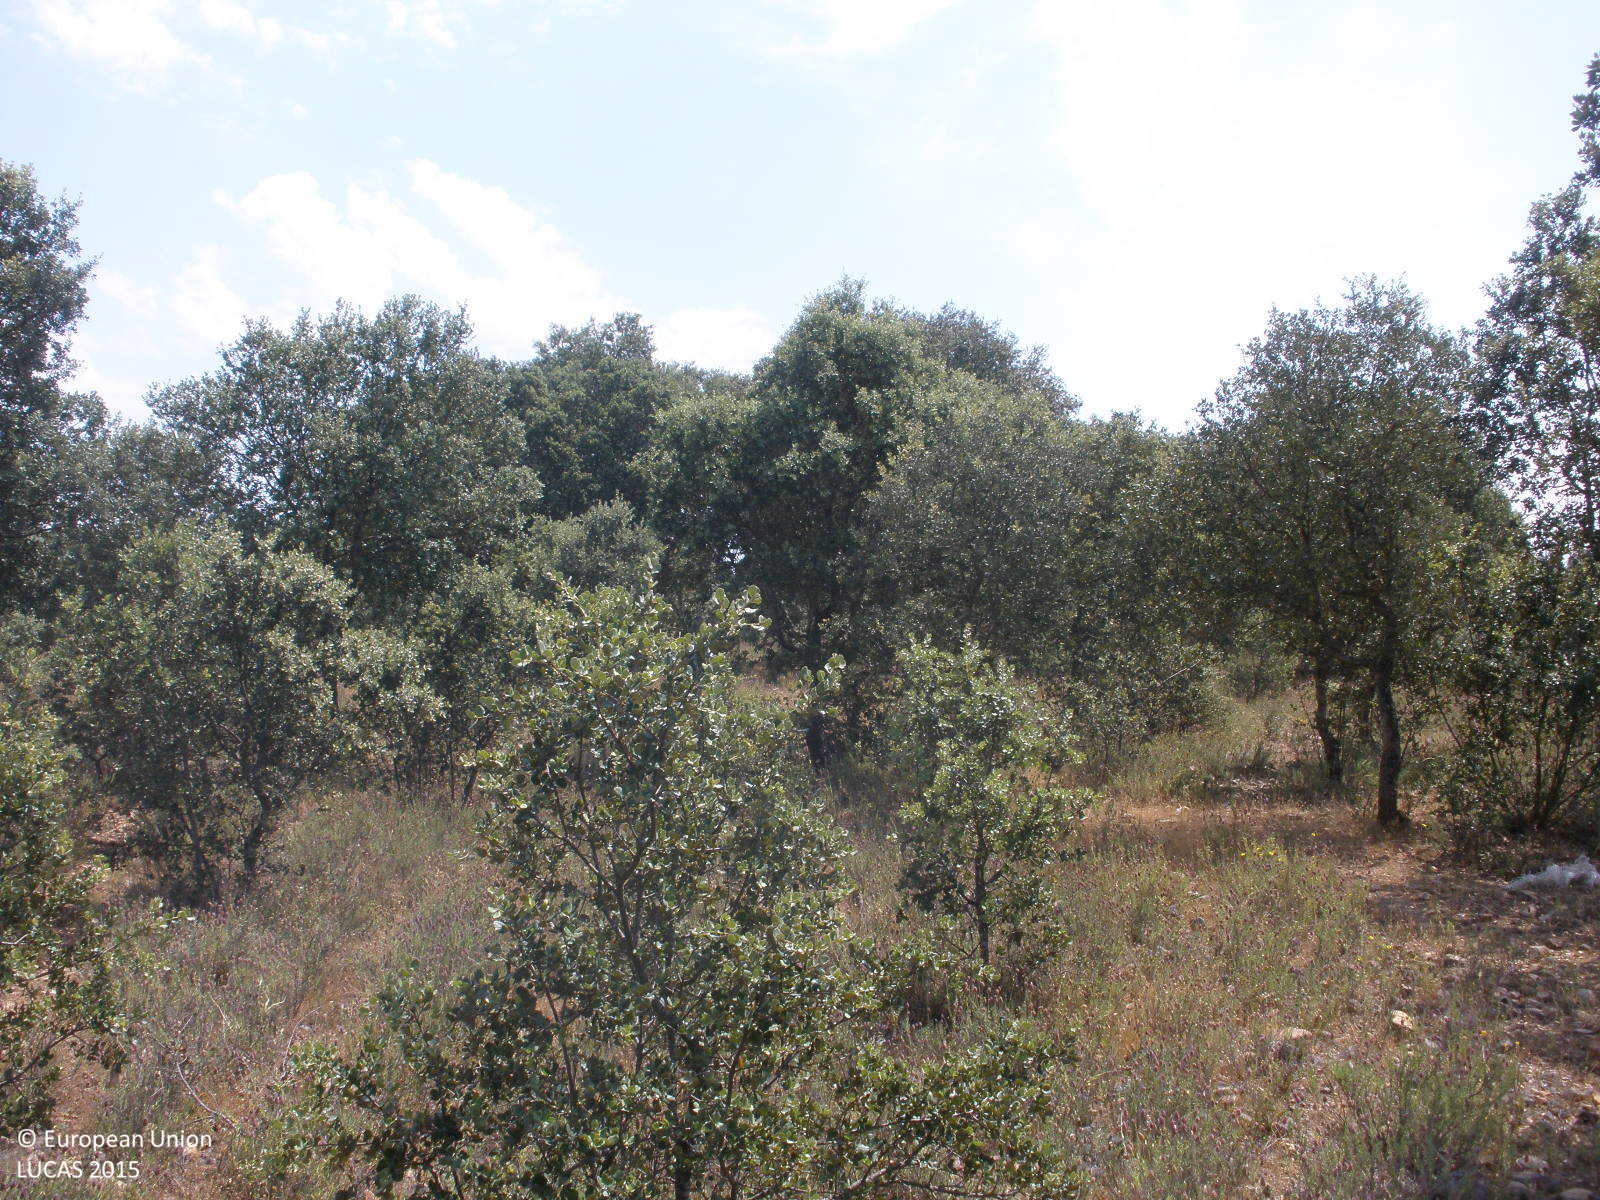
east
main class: Woodland
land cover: Broadleaved woodland
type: broadleaved evergreen forest
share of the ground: > 75 %
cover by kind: broadleaved forest trees 40 %, shrubs 40 %, herbaceous plants 20 %
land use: Forestry
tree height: > 5 m
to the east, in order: Broadleaved woodland; Fences; Broadleaved woodland; Fences; Other bare soil; Ponds and wetlands; Broadleaved woodland; Fences; Tracks; Fences; Broadleaved woodland
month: June
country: ES
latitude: 40.6431
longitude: -6.2974
